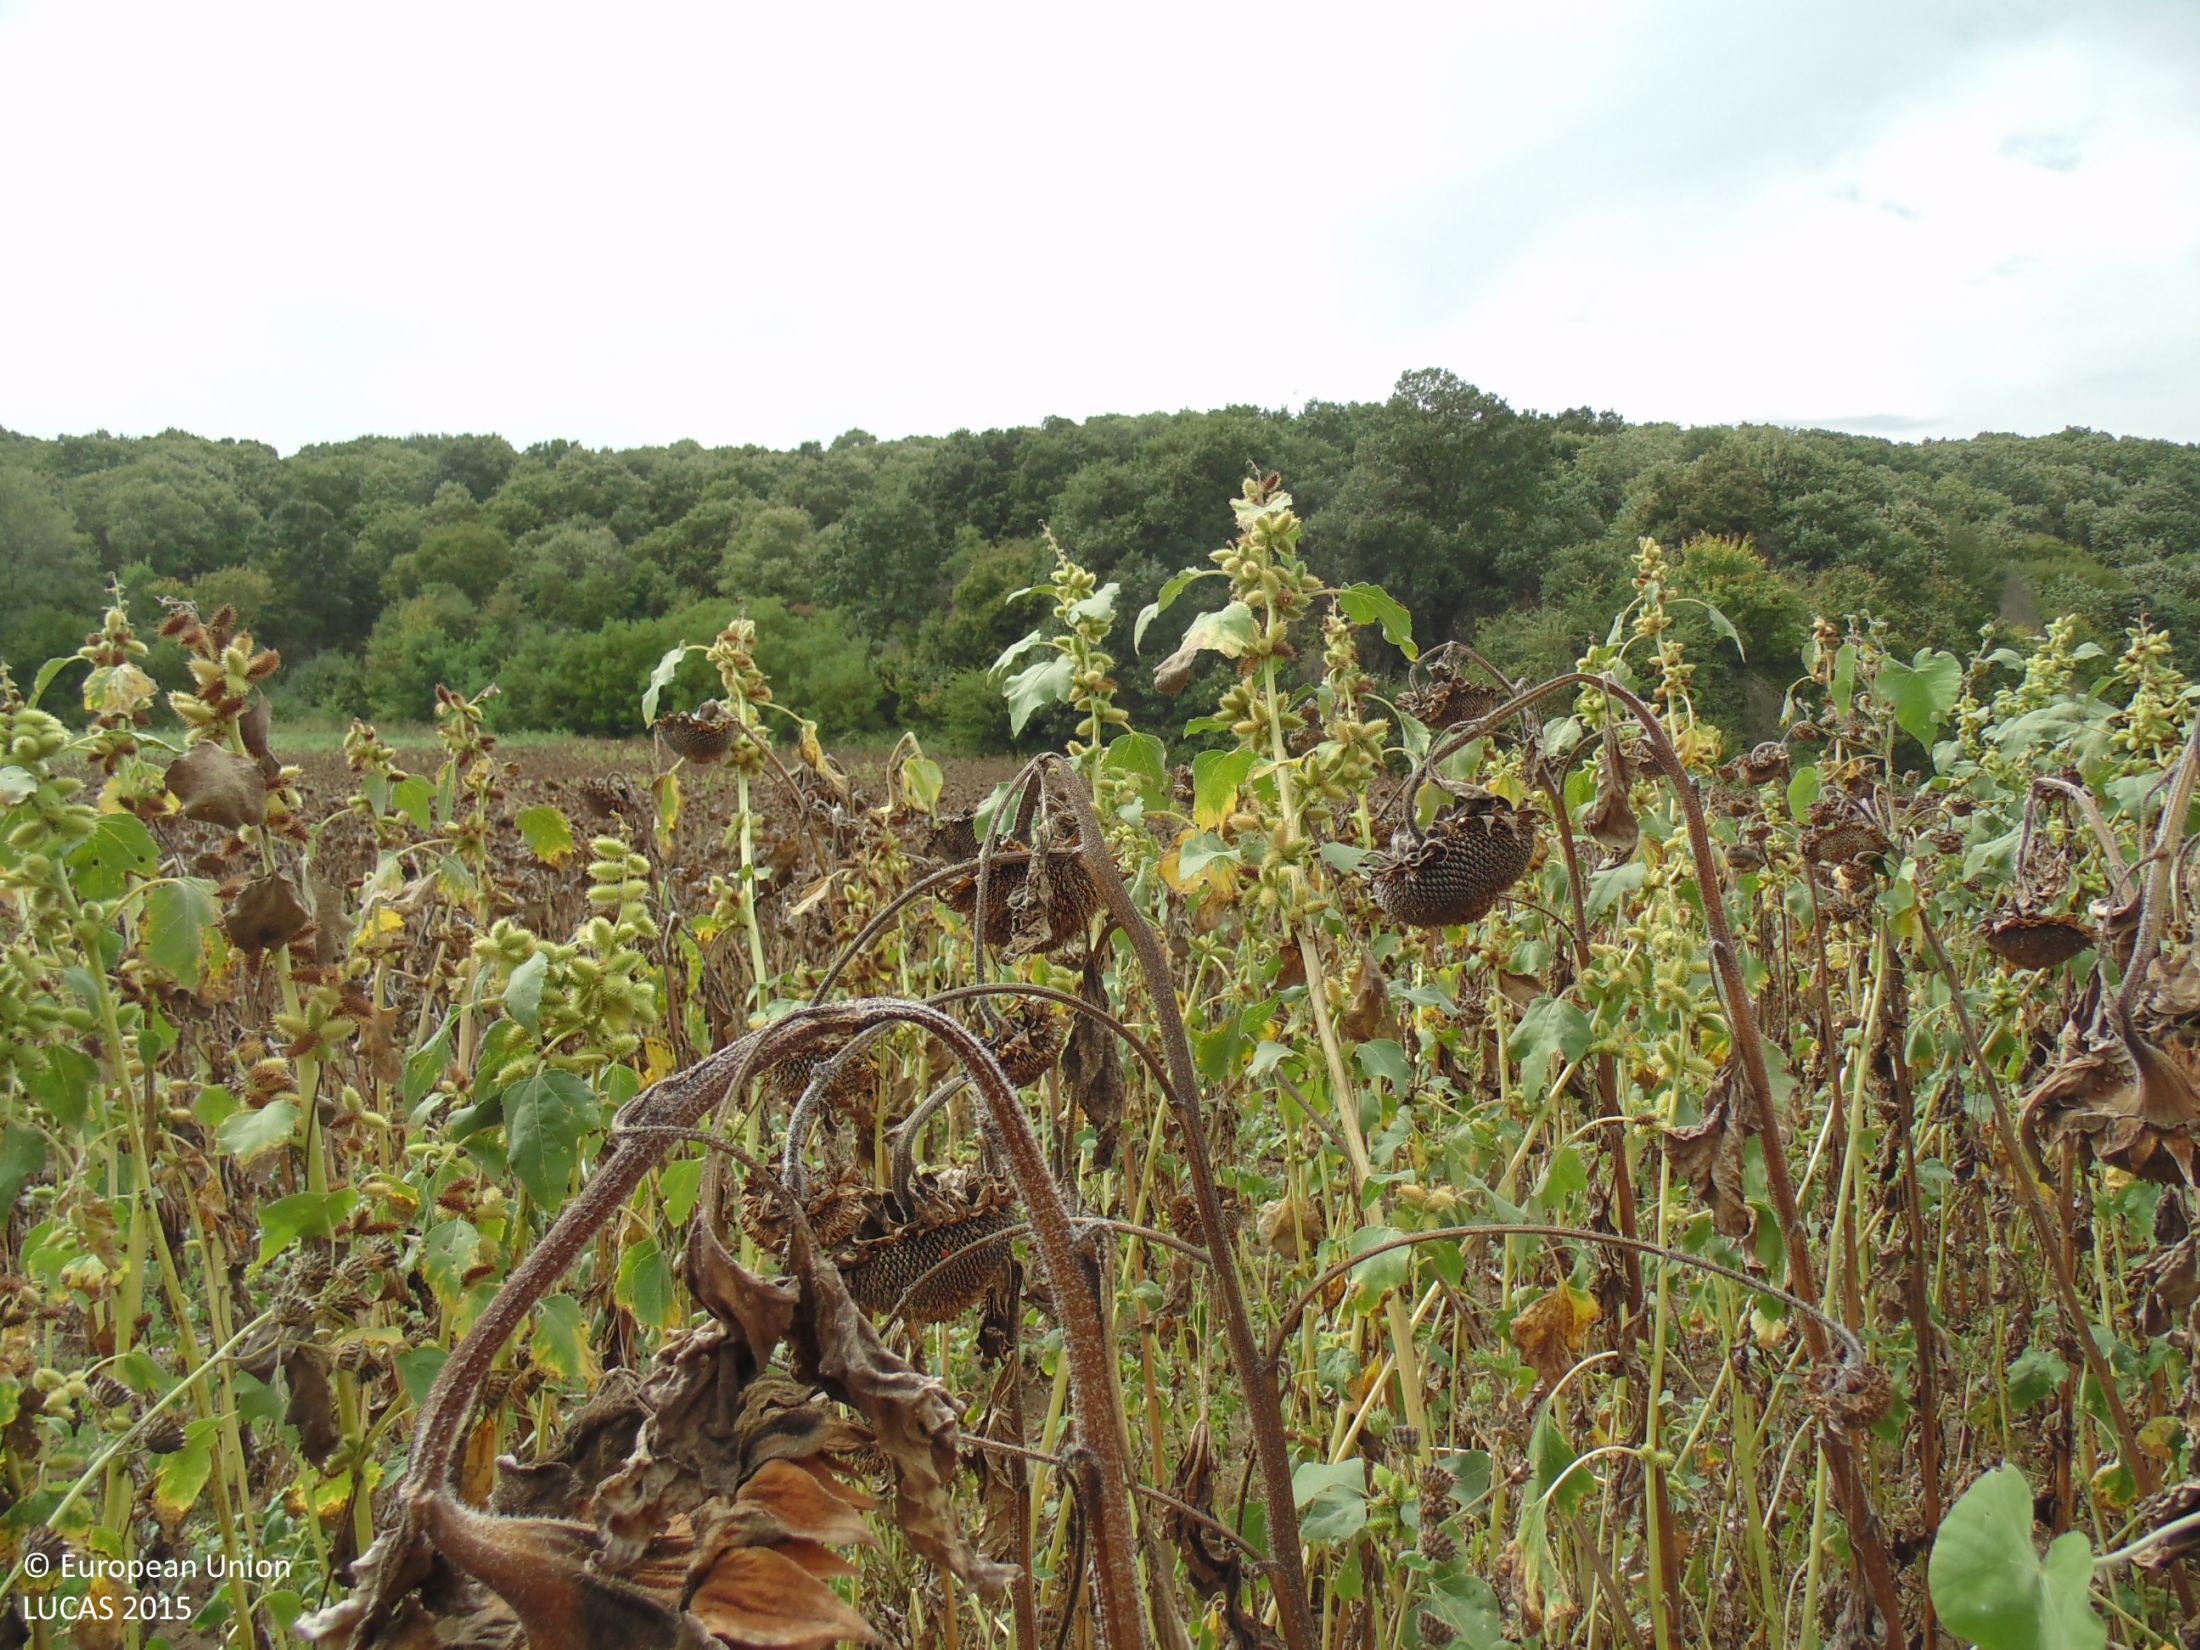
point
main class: Cropland
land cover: Sunflower
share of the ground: > 75 %
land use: Agriculture (excluding fallow land and kitchen gardens)
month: September
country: BG
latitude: 43.9661
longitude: 27.2166
